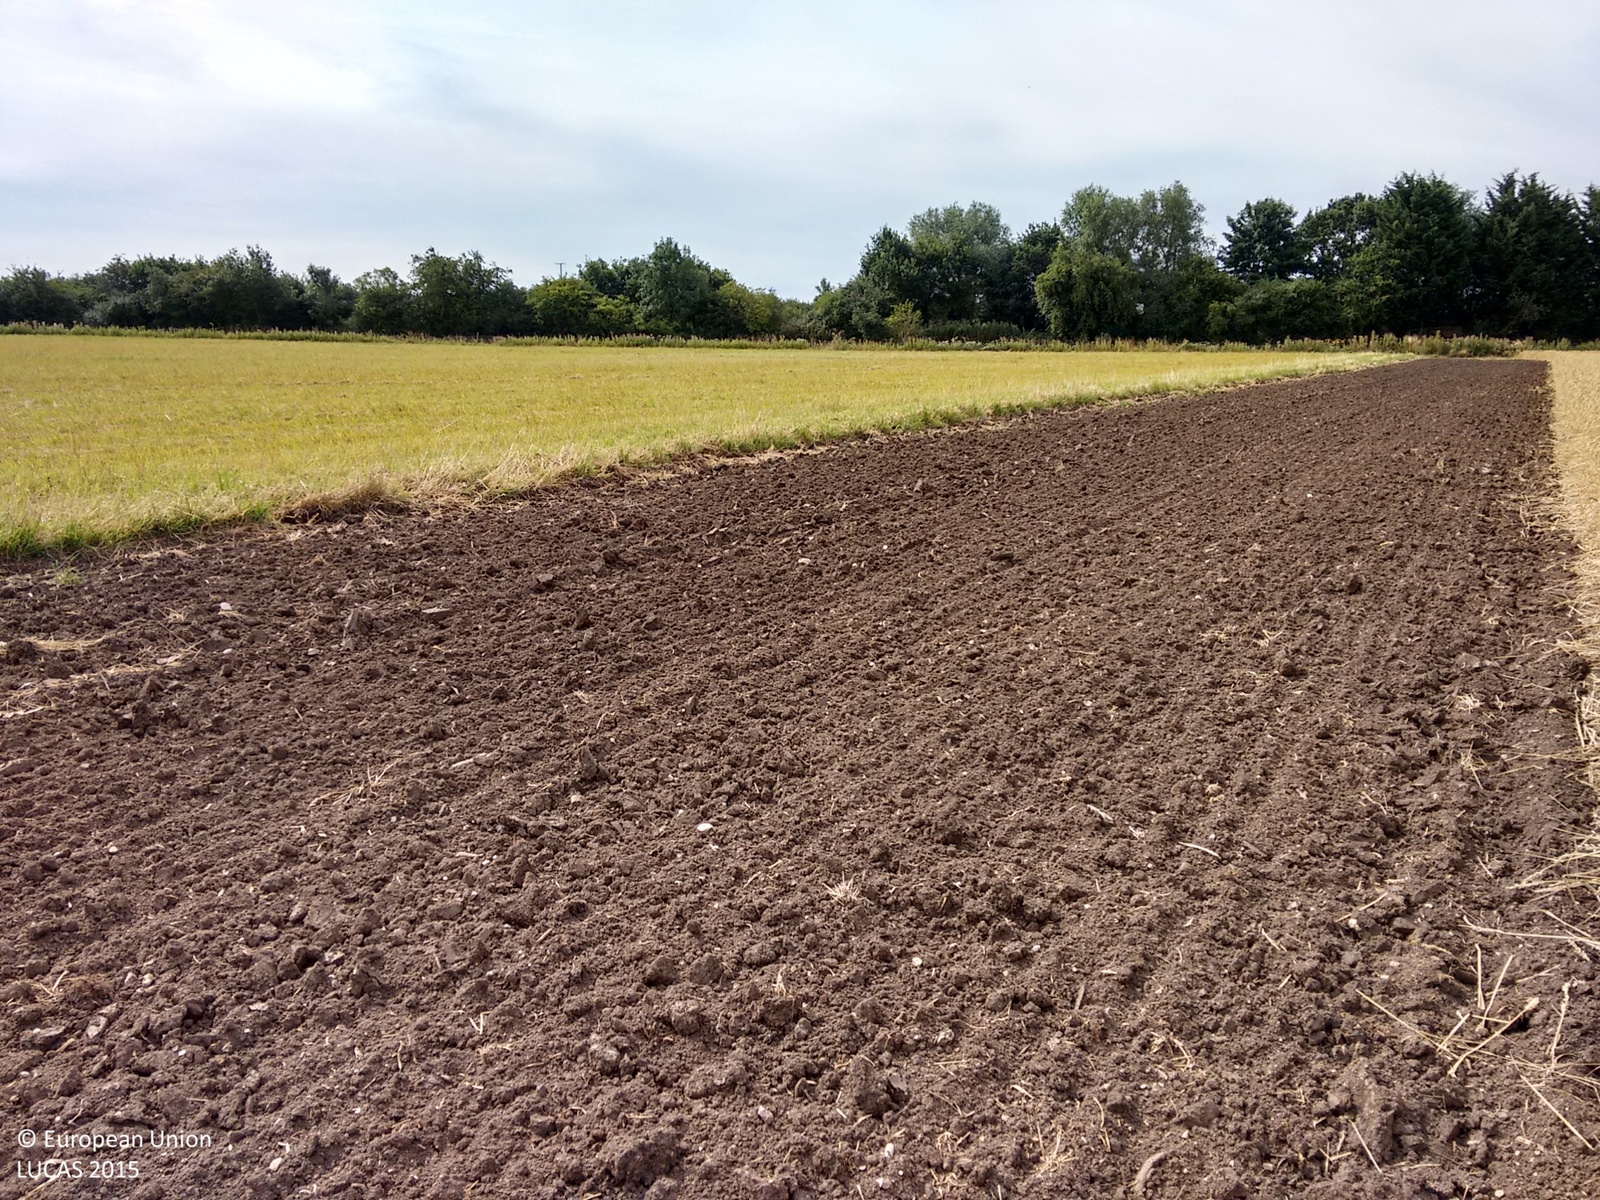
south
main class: Cropland
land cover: Common wheat
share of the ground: > 75 %
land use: Agriculture (excluding fallow land and kitchen gardens)
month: August
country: GB
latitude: 52.5715
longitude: 0.4553
